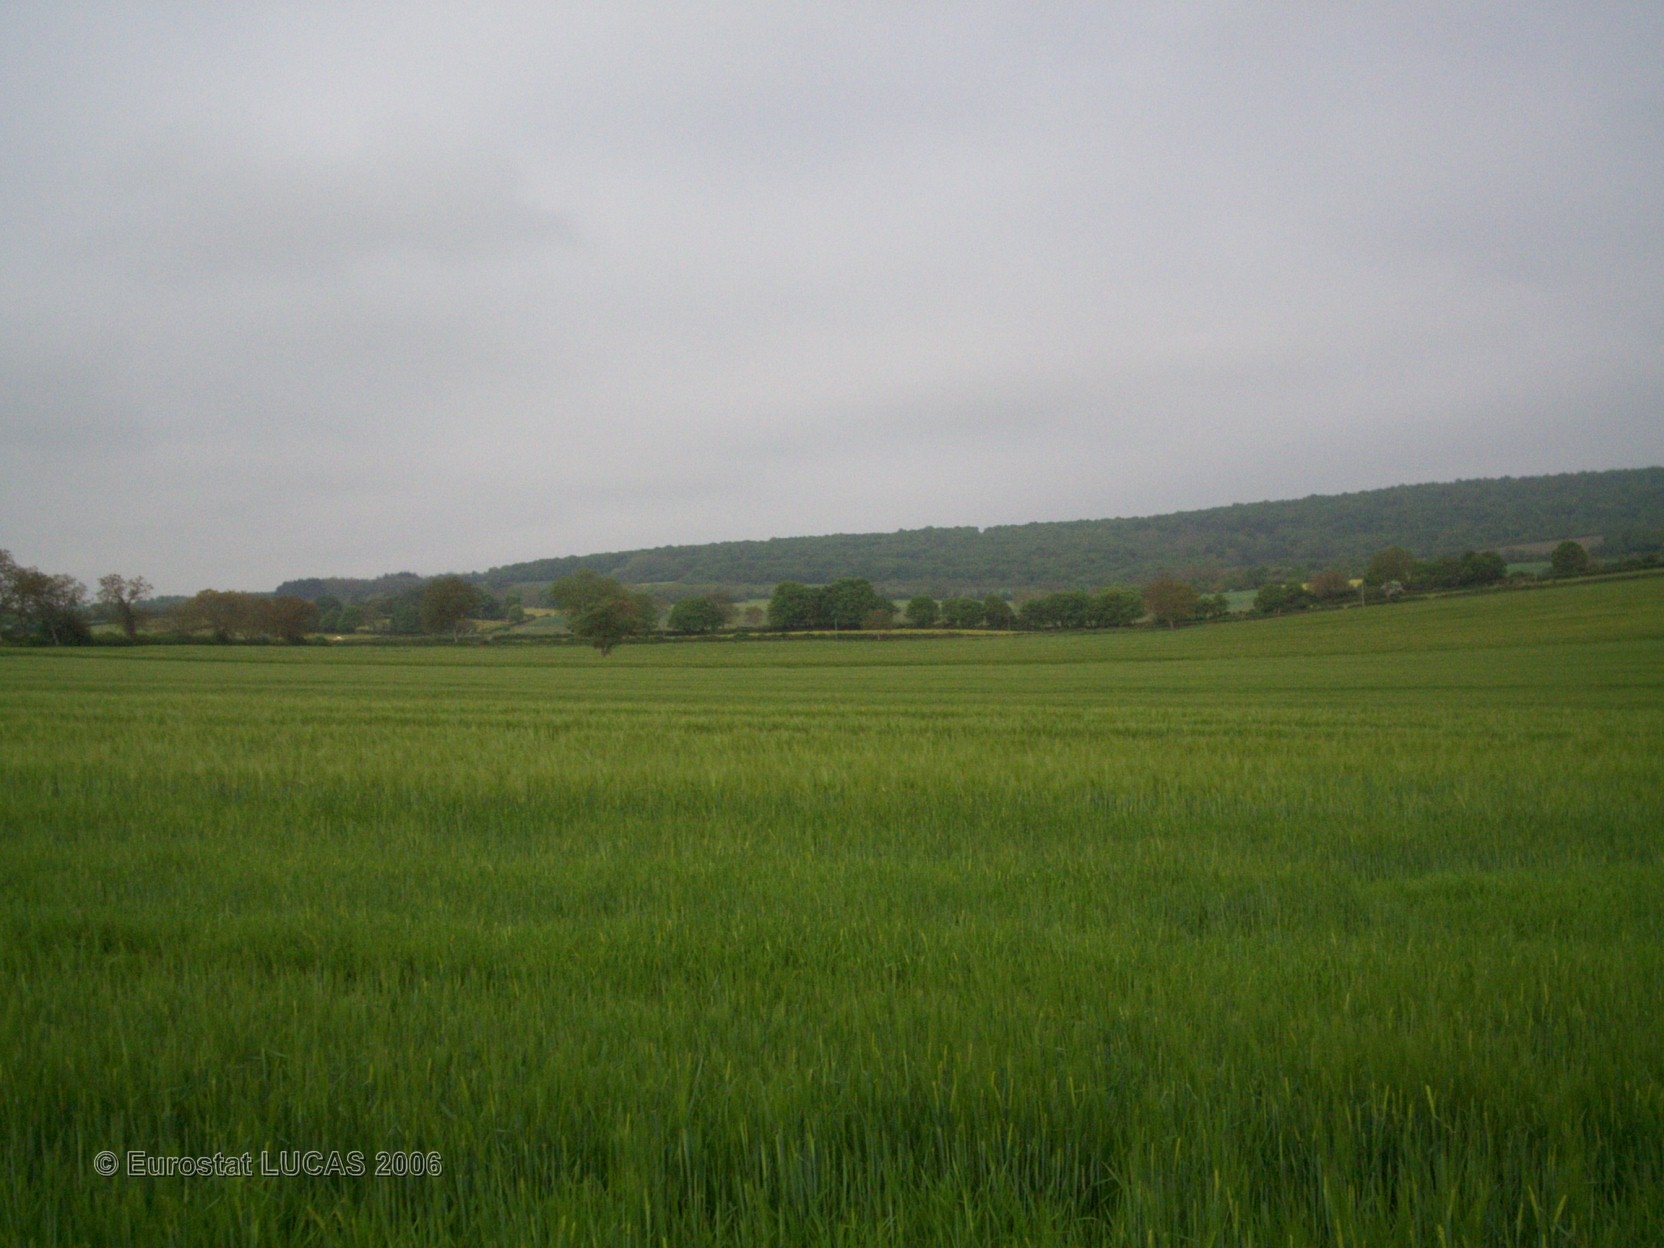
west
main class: Cropland
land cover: Barley
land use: Agriculture (excluding fallow land and kitchen gardens)
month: May
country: FR
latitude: 46.5059
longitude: 4.6455
